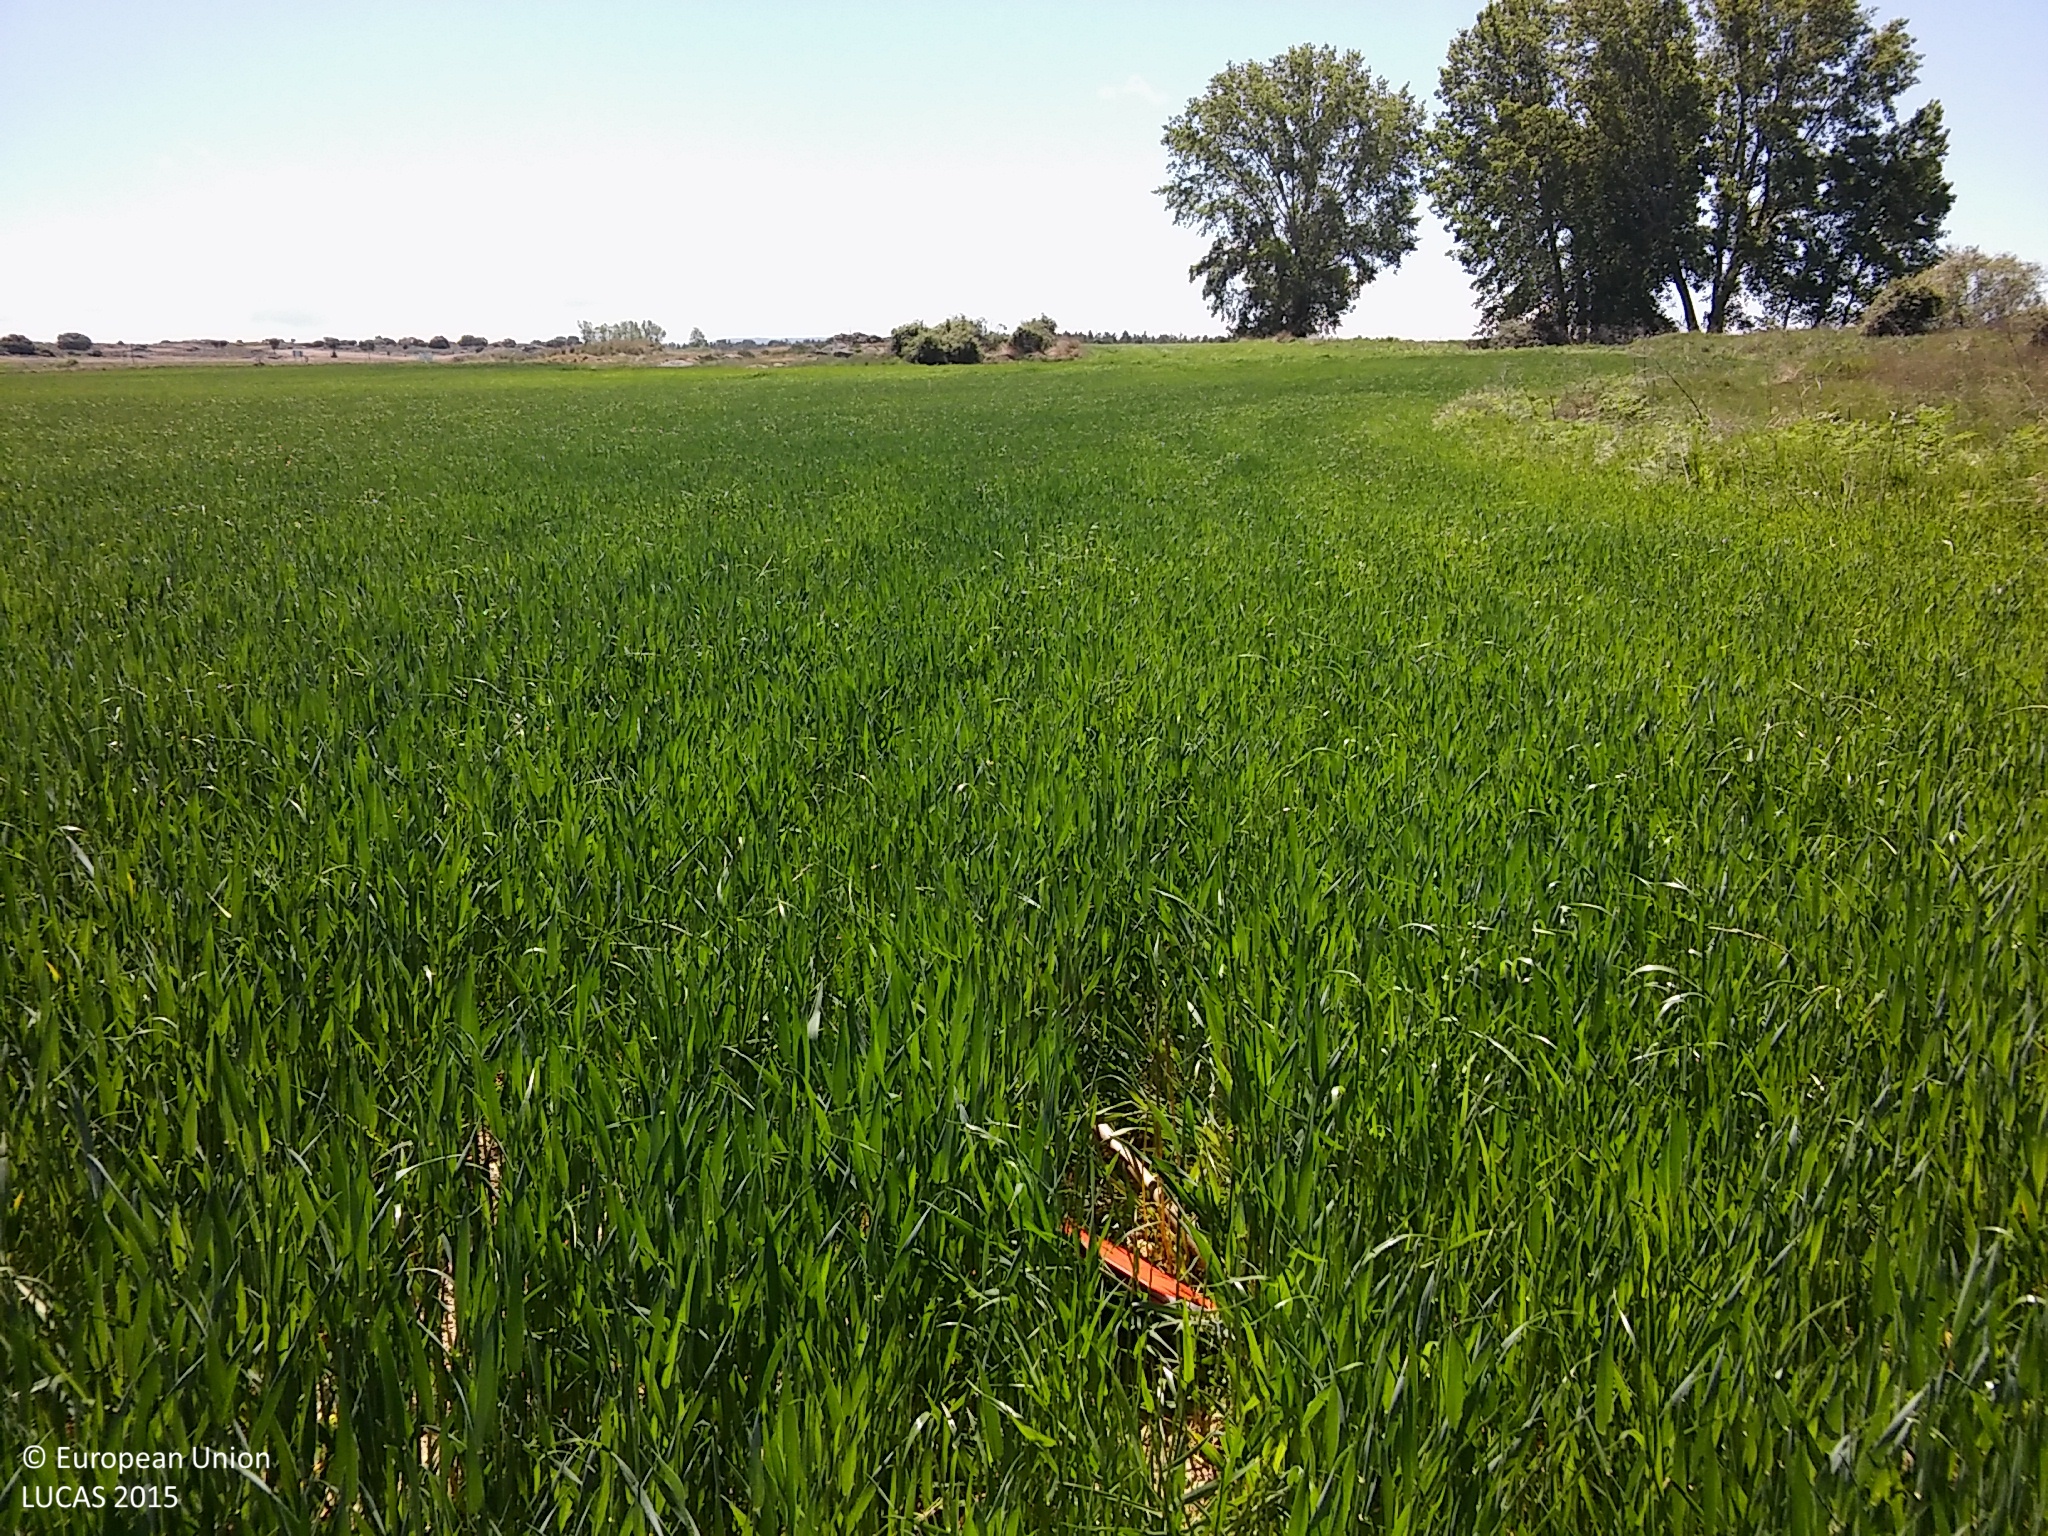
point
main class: Cropland
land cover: Common wheat
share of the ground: > 75 %
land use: Agriculture (excluding fallow land and kitchen gardens)
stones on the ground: < 10 %
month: May
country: ES
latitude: 41.1516
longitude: -3.9562
